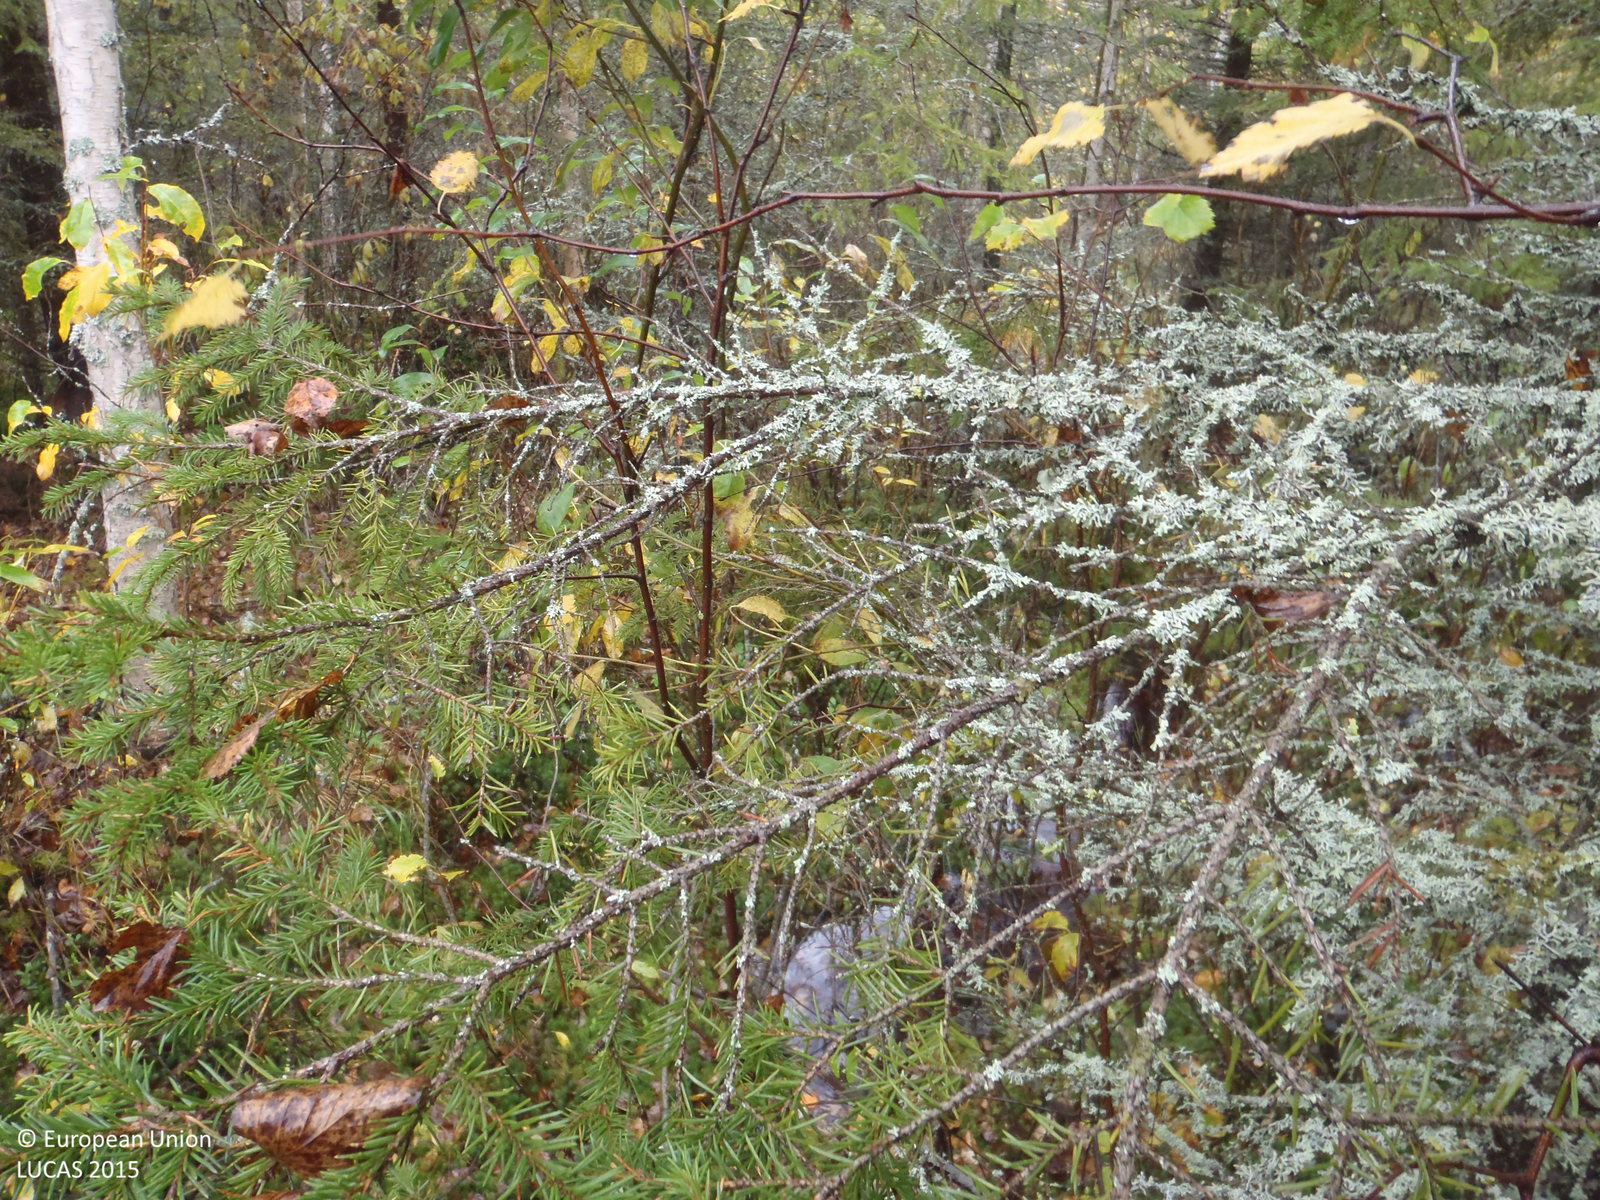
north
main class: Woodland
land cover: Spruce dominated coniferous woodland
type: boreal forest
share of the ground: > 75 %
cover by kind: coniferous forest trees 70 %, broadleaved forest trees 20 %, shrubs 5 %, herbaceous plants 5 %
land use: Forestry
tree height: > 5 m
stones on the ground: < 10 %
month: September
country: FI
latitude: 65.1569
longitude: 26.5104
